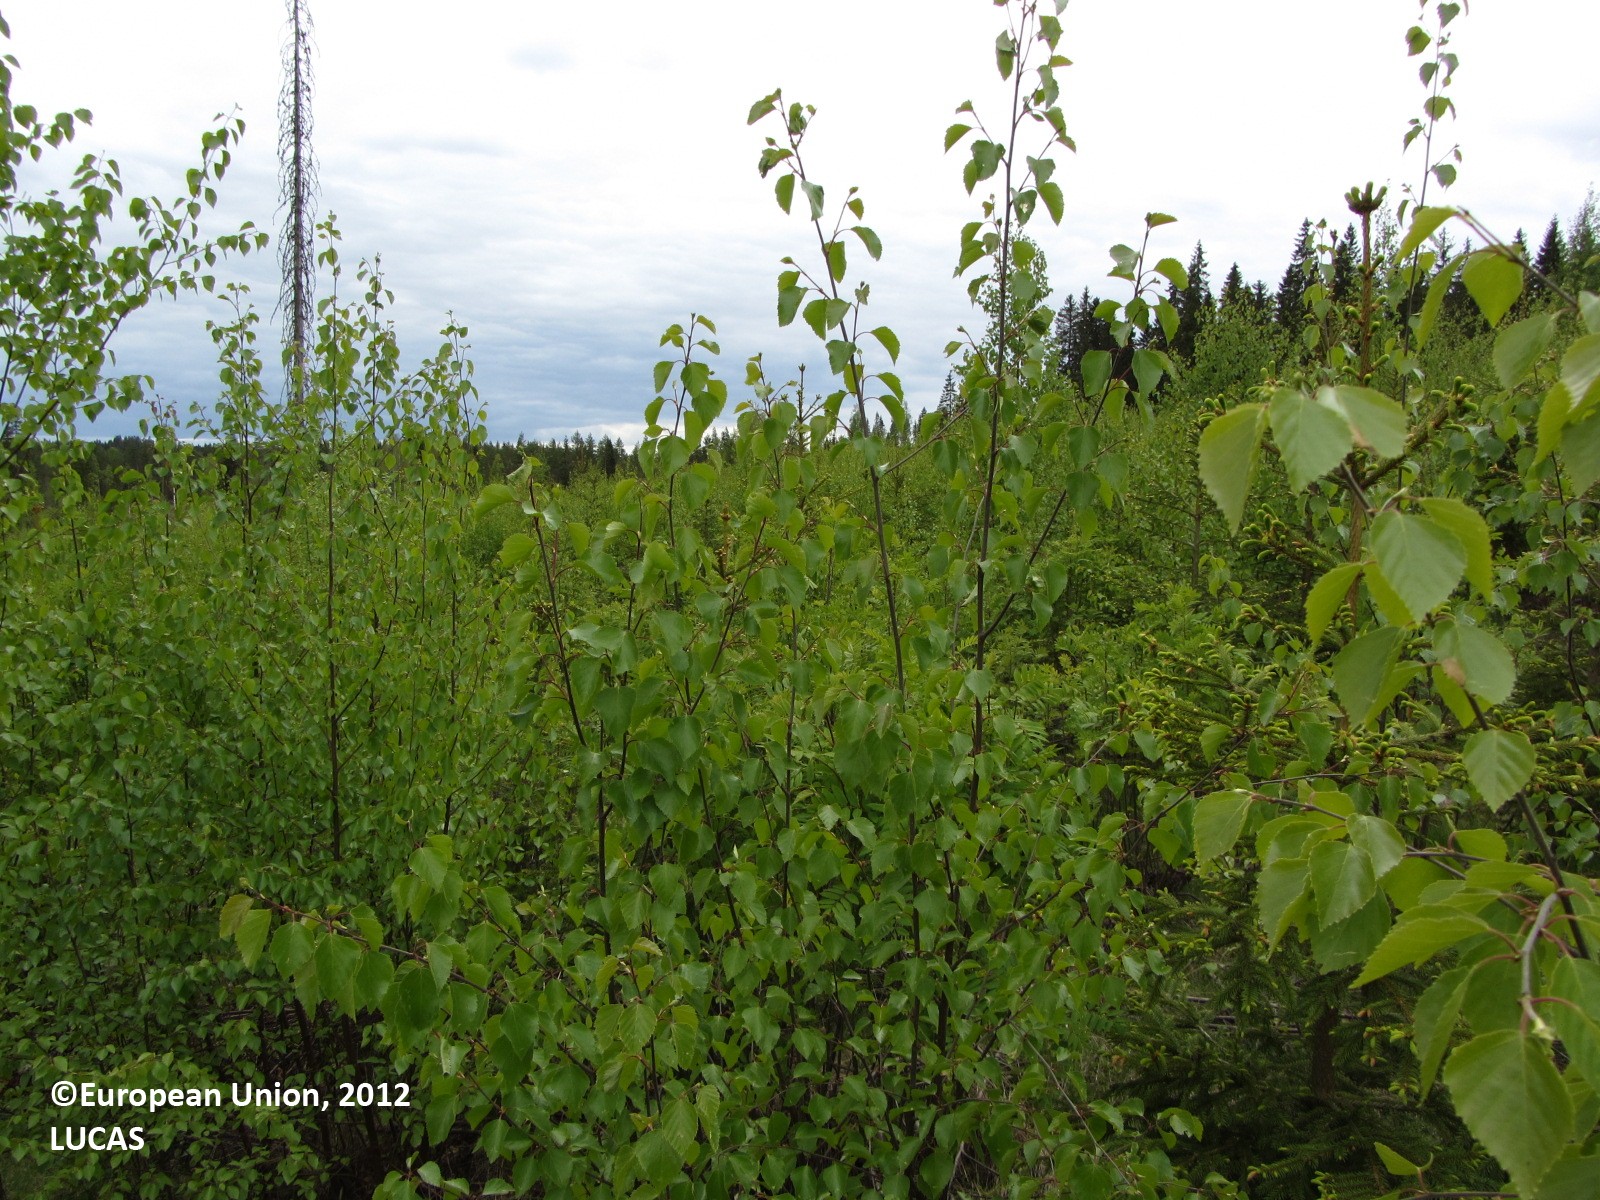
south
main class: Woodland
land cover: Spruce dominated mixed woodland
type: boreal forest
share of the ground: > 75 %
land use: Forestry
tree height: < 5 m
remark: Nursery
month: May
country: FI
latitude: 62.2360
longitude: 25.4102
